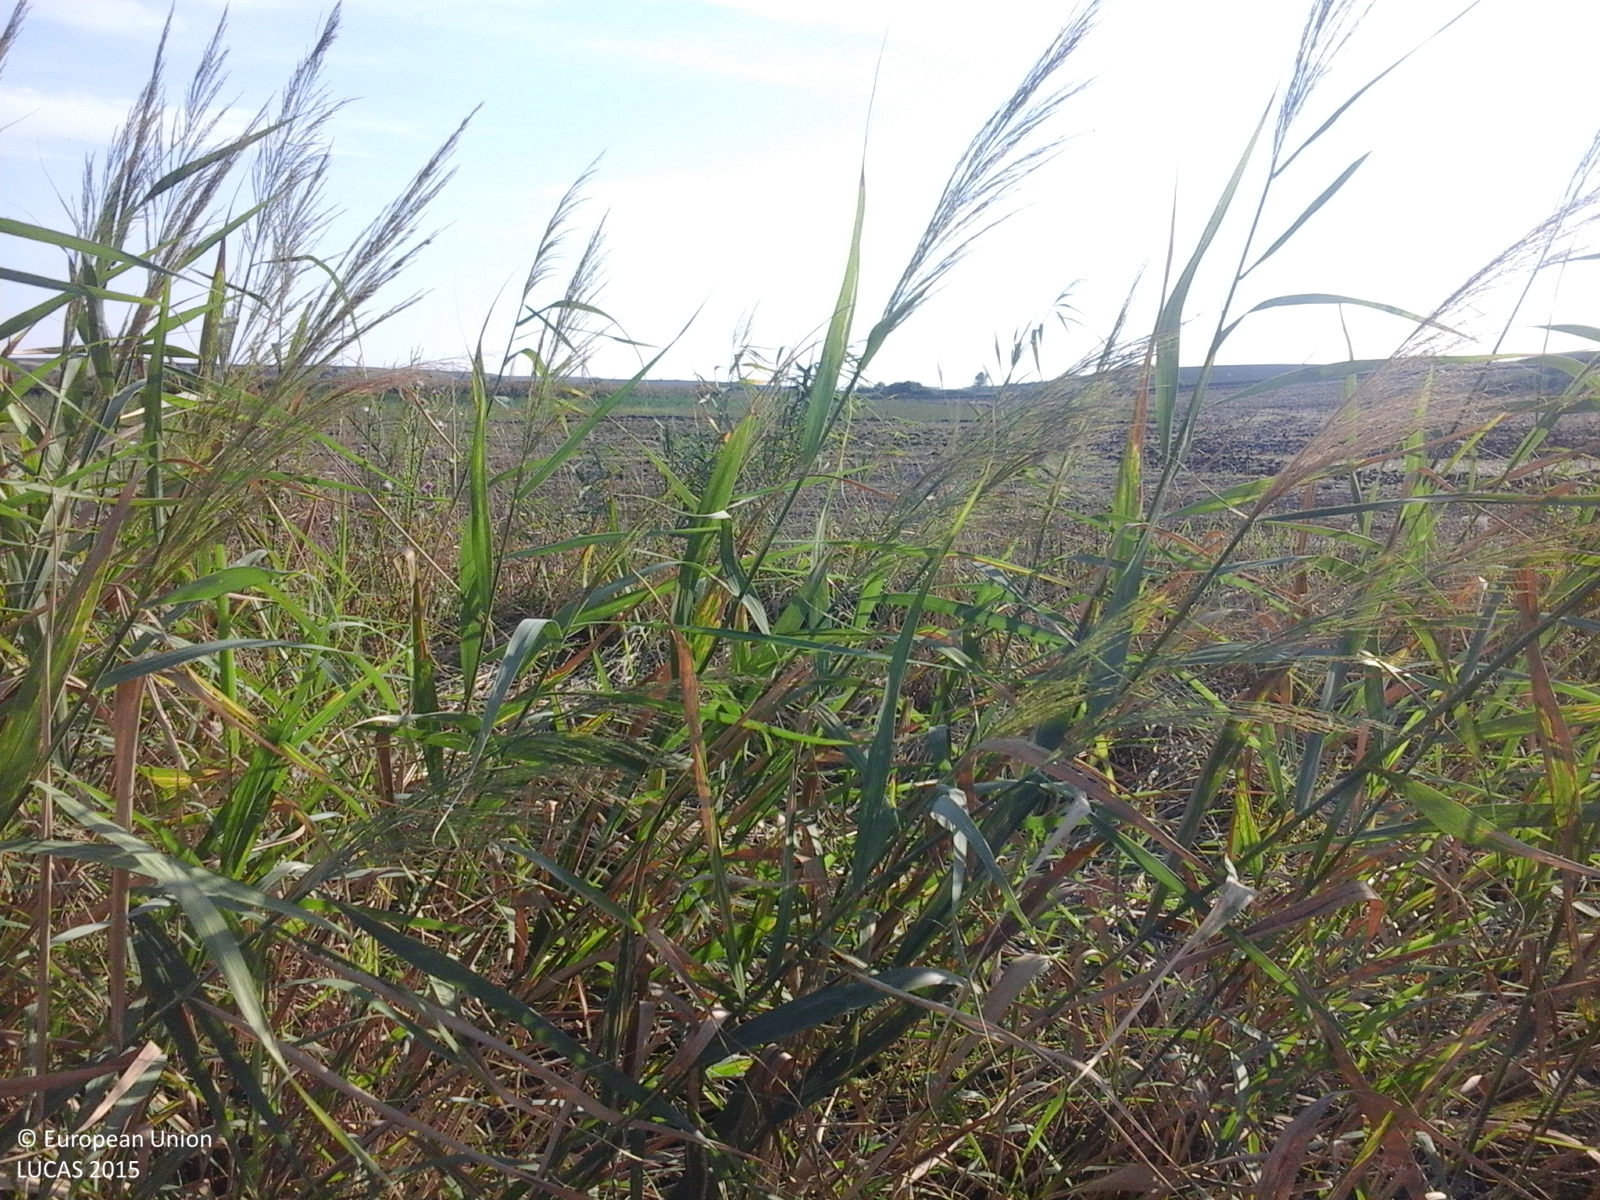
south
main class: Grassland
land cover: Spontaneously vegetated surfaces
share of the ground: > 75 %
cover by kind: herbaceous plants 100 %
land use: Fallow land
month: August
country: RO
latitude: 46.0533
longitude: 21.1858
